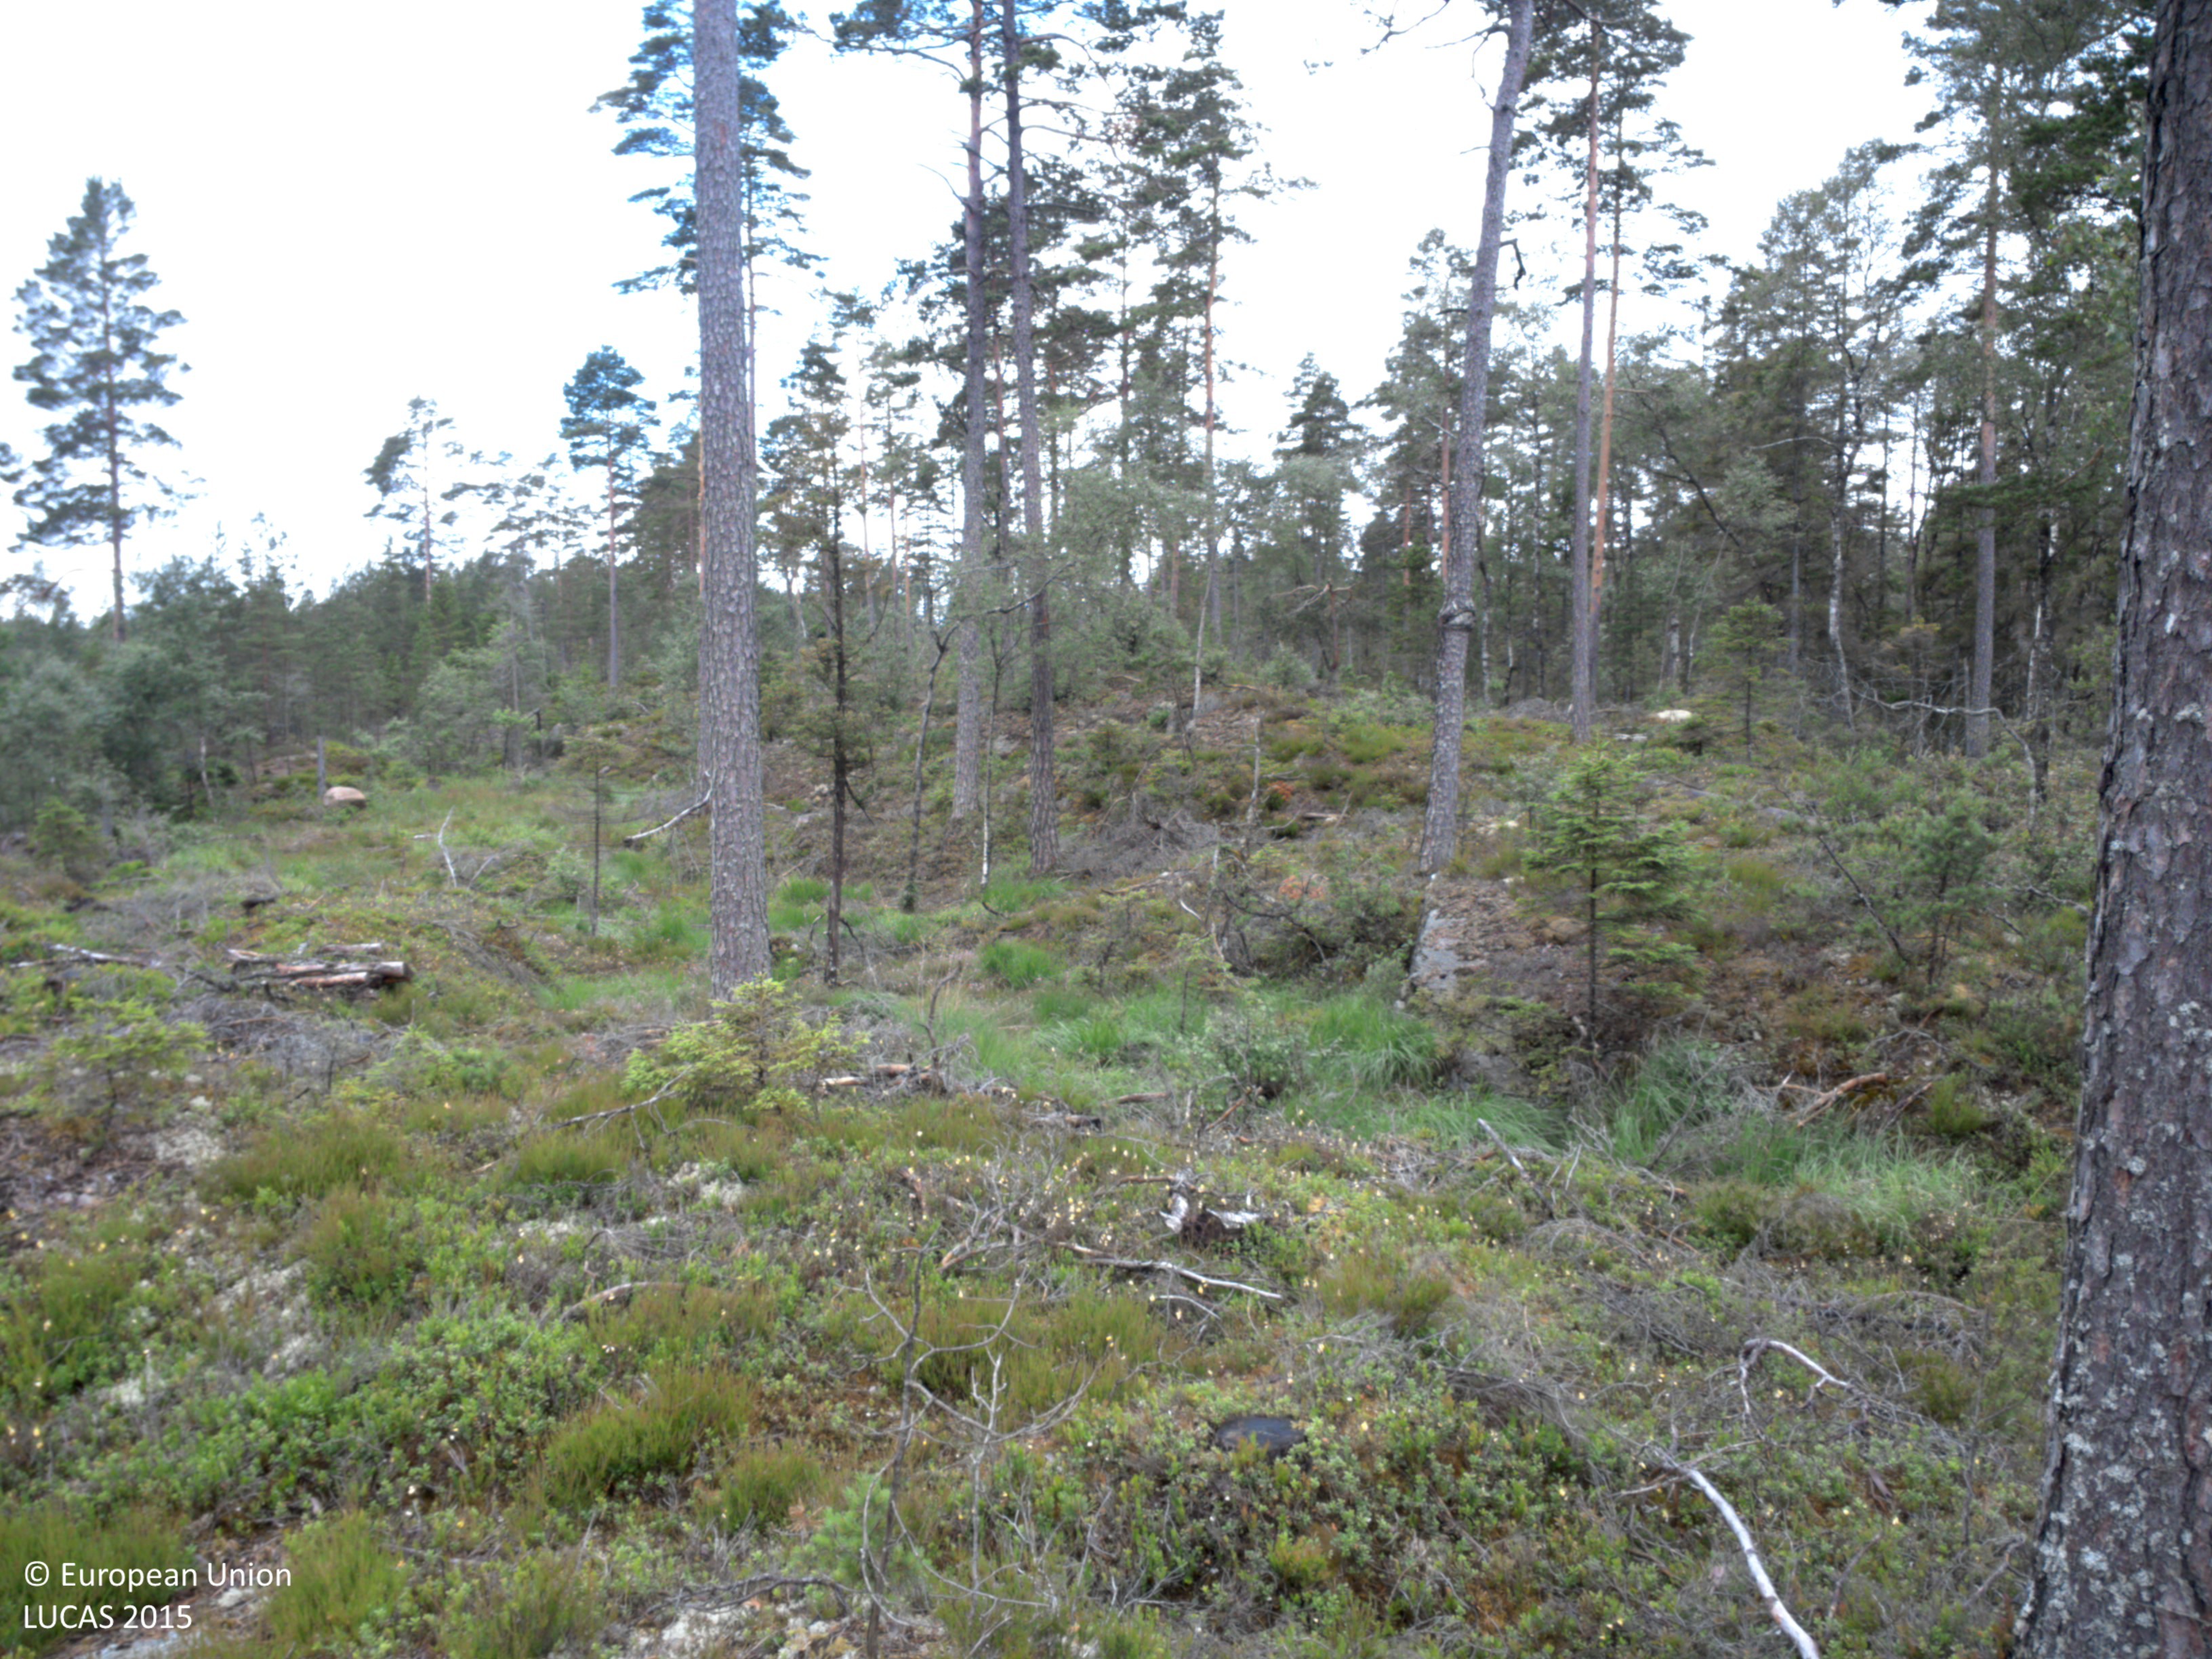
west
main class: Woodland
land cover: Pine dominated coniferous woodland
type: boreal forest
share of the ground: 25 - 50 %
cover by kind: coniferous forest trees 25 %, herbaceous plants 25 %, lichens and mosses 25 %, shrubs 15 %, consolidated bare surface 10 %
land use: Forestry
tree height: > 5 m
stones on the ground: < 10 %
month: July
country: SE
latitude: 58.7044
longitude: 12.2562
